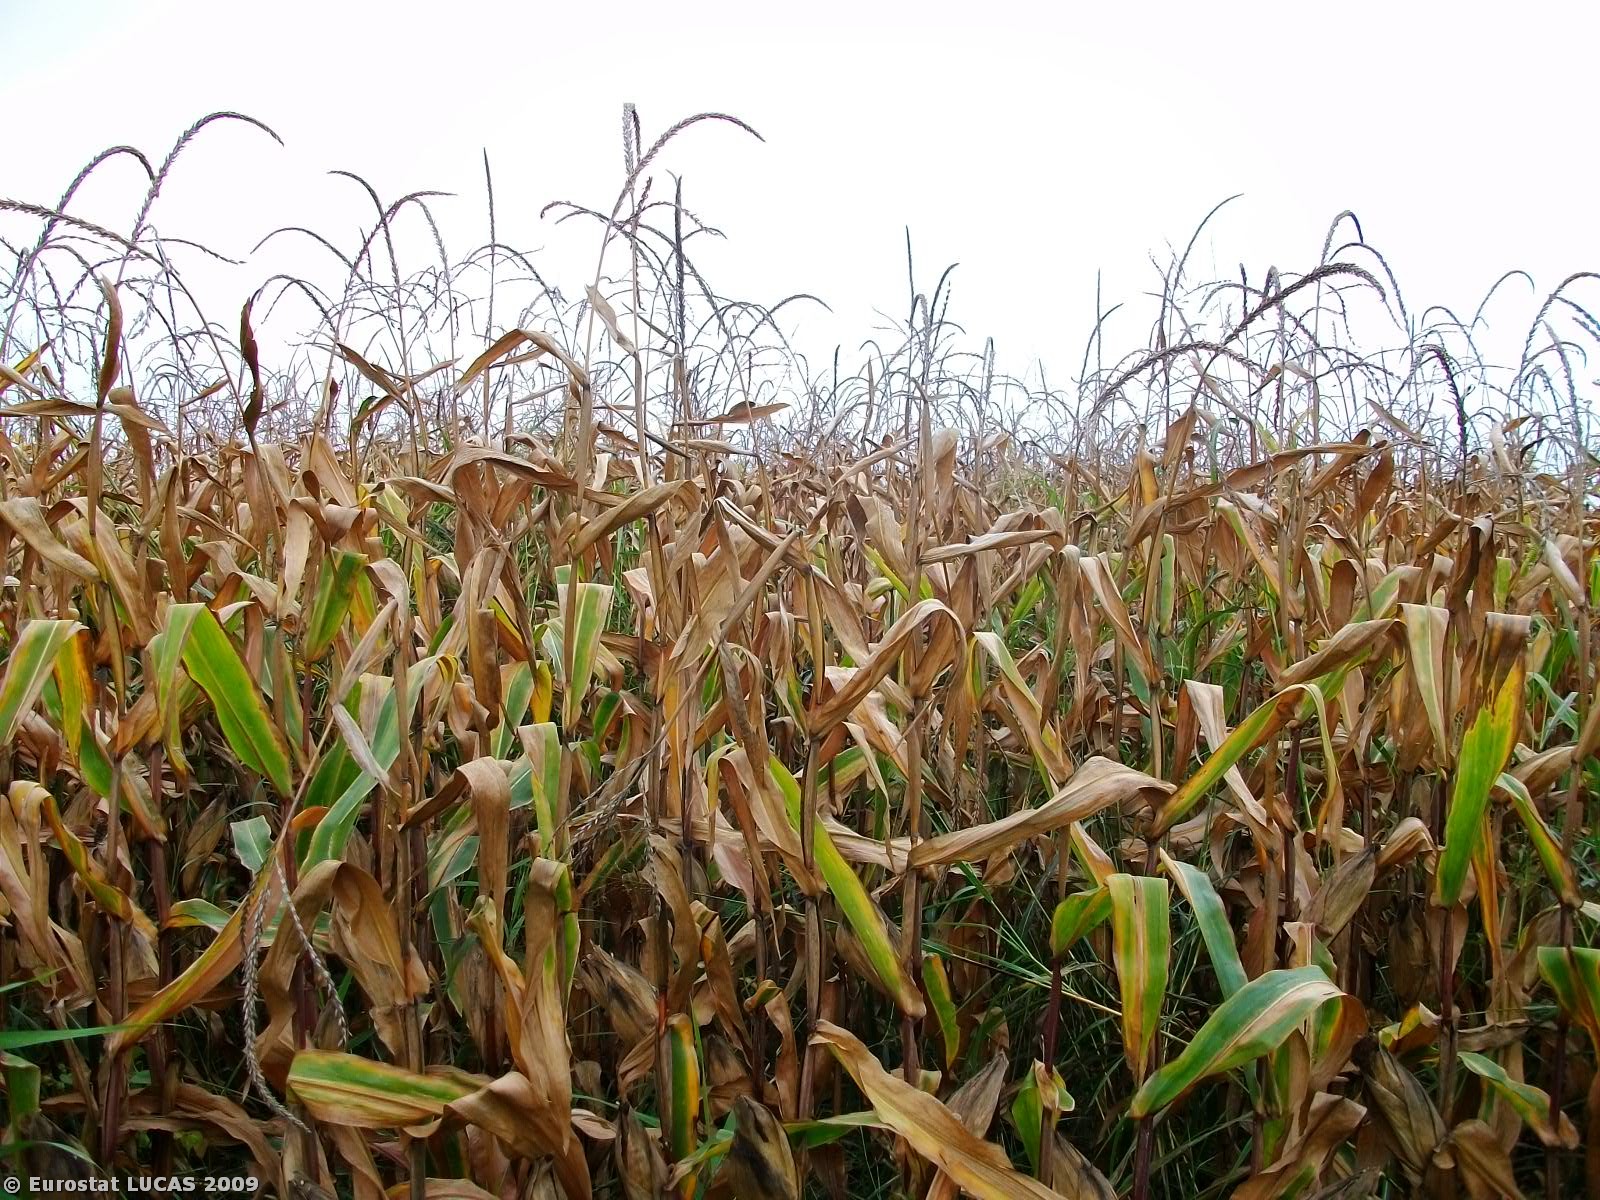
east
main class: Cropland
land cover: Maize
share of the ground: > 75 %
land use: Agriculture (excluding fallow land and kitchen gardens)
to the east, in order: Maize; Grass margins; Tracks; Grass margins; Maize; Tracks; Grassland with sparse tree/shrub cover; Ditches and canals; Abandoned hedges; Spontaneously vegetated surfaces
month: September
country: GR
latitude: 40.9602
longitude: 23.6237
